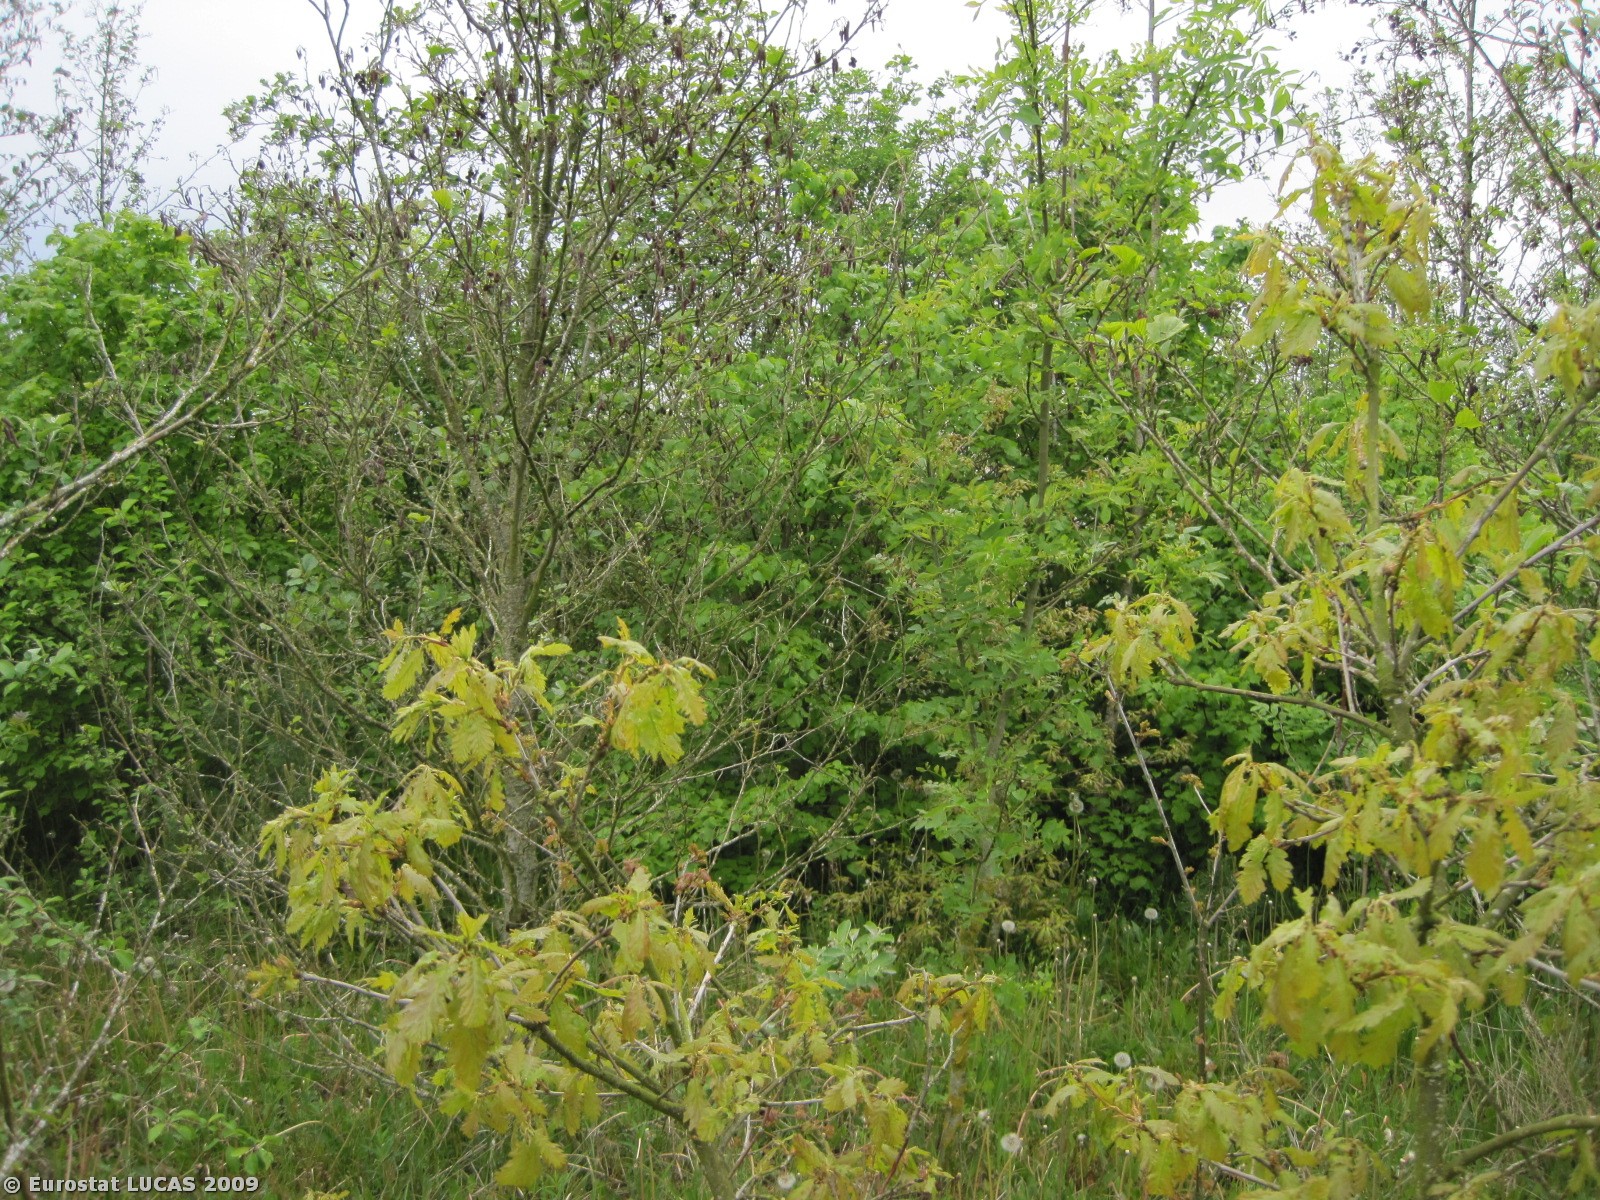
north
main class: Woodland
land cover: Broadleaved woodland
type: plantations and self-sown exotic forest
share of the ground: > 75 %
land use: Forestry
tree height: > 5 m
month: May
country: DK
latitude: 56.7270
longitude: 9.9837
